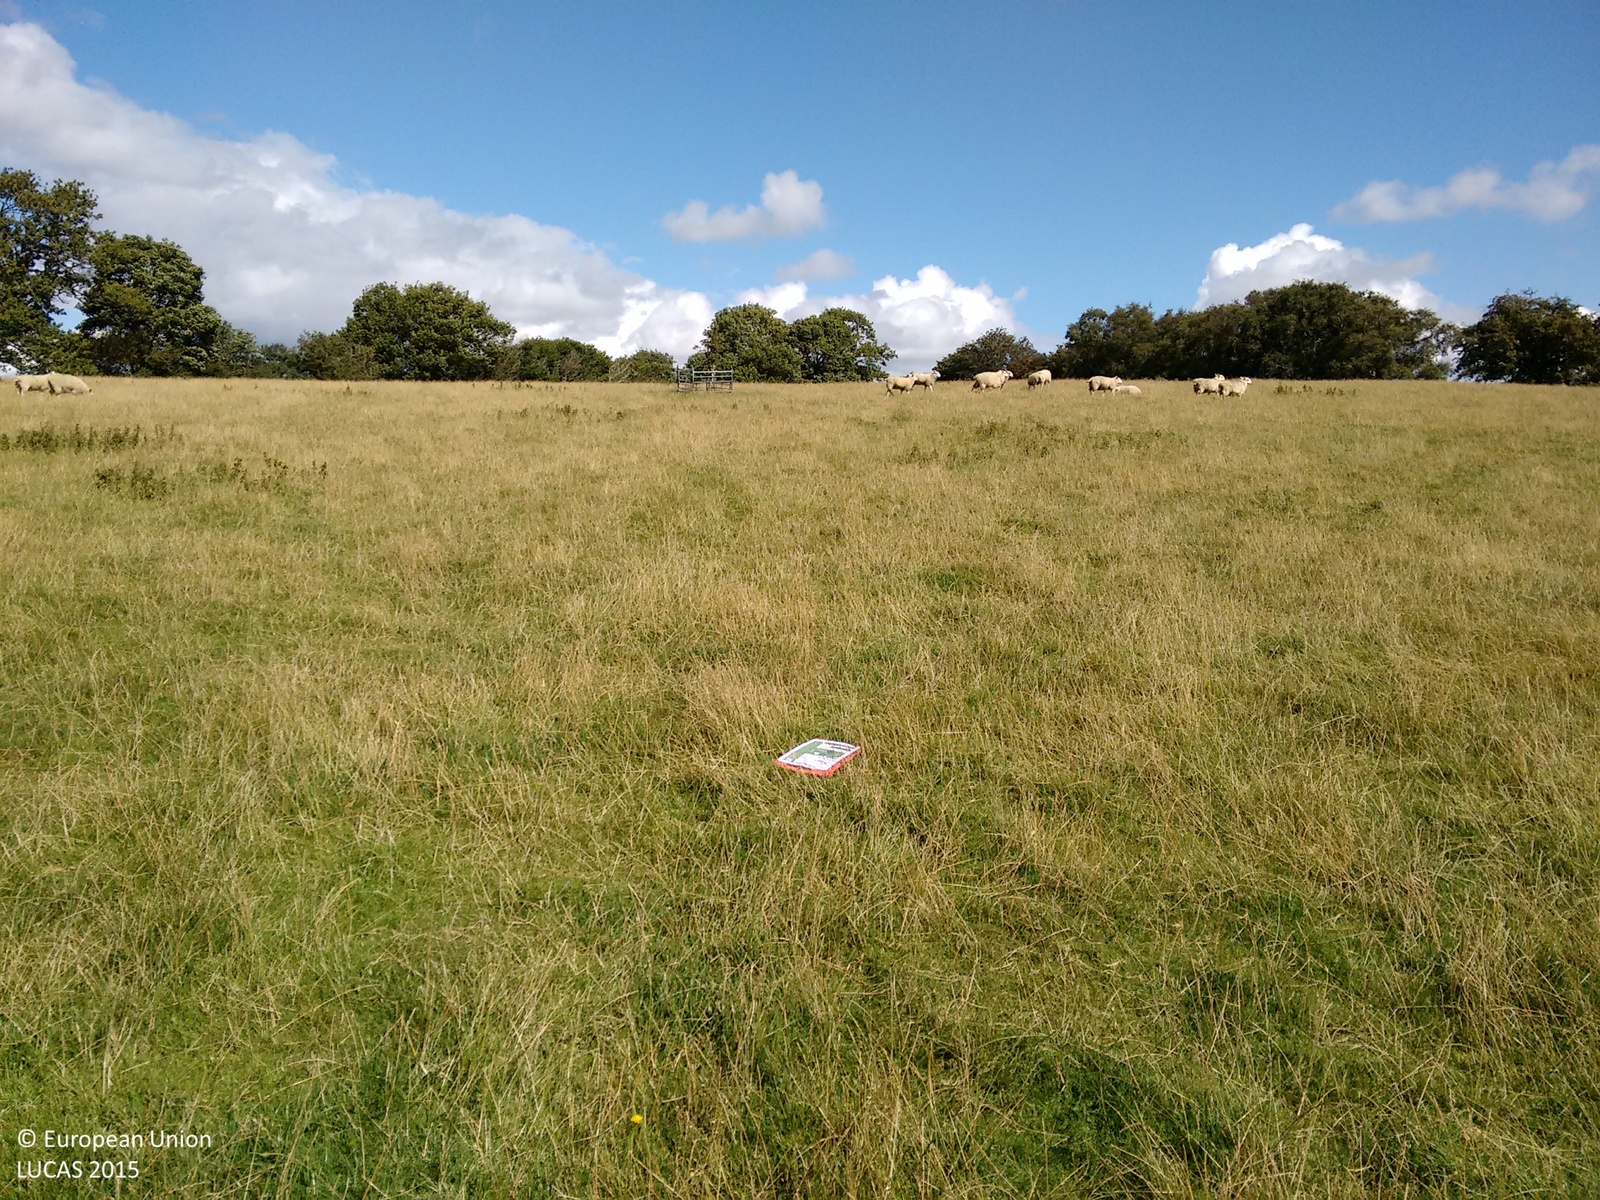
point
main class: Grassland
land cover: Grassland without tree/shrub cover
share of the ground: > 75 %
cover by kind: herbaceous plants 100 %
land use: Agriculture (excluding fallow land and kitchen gardens)
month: August
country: GB
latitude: 53.1701
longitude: -3.5027
